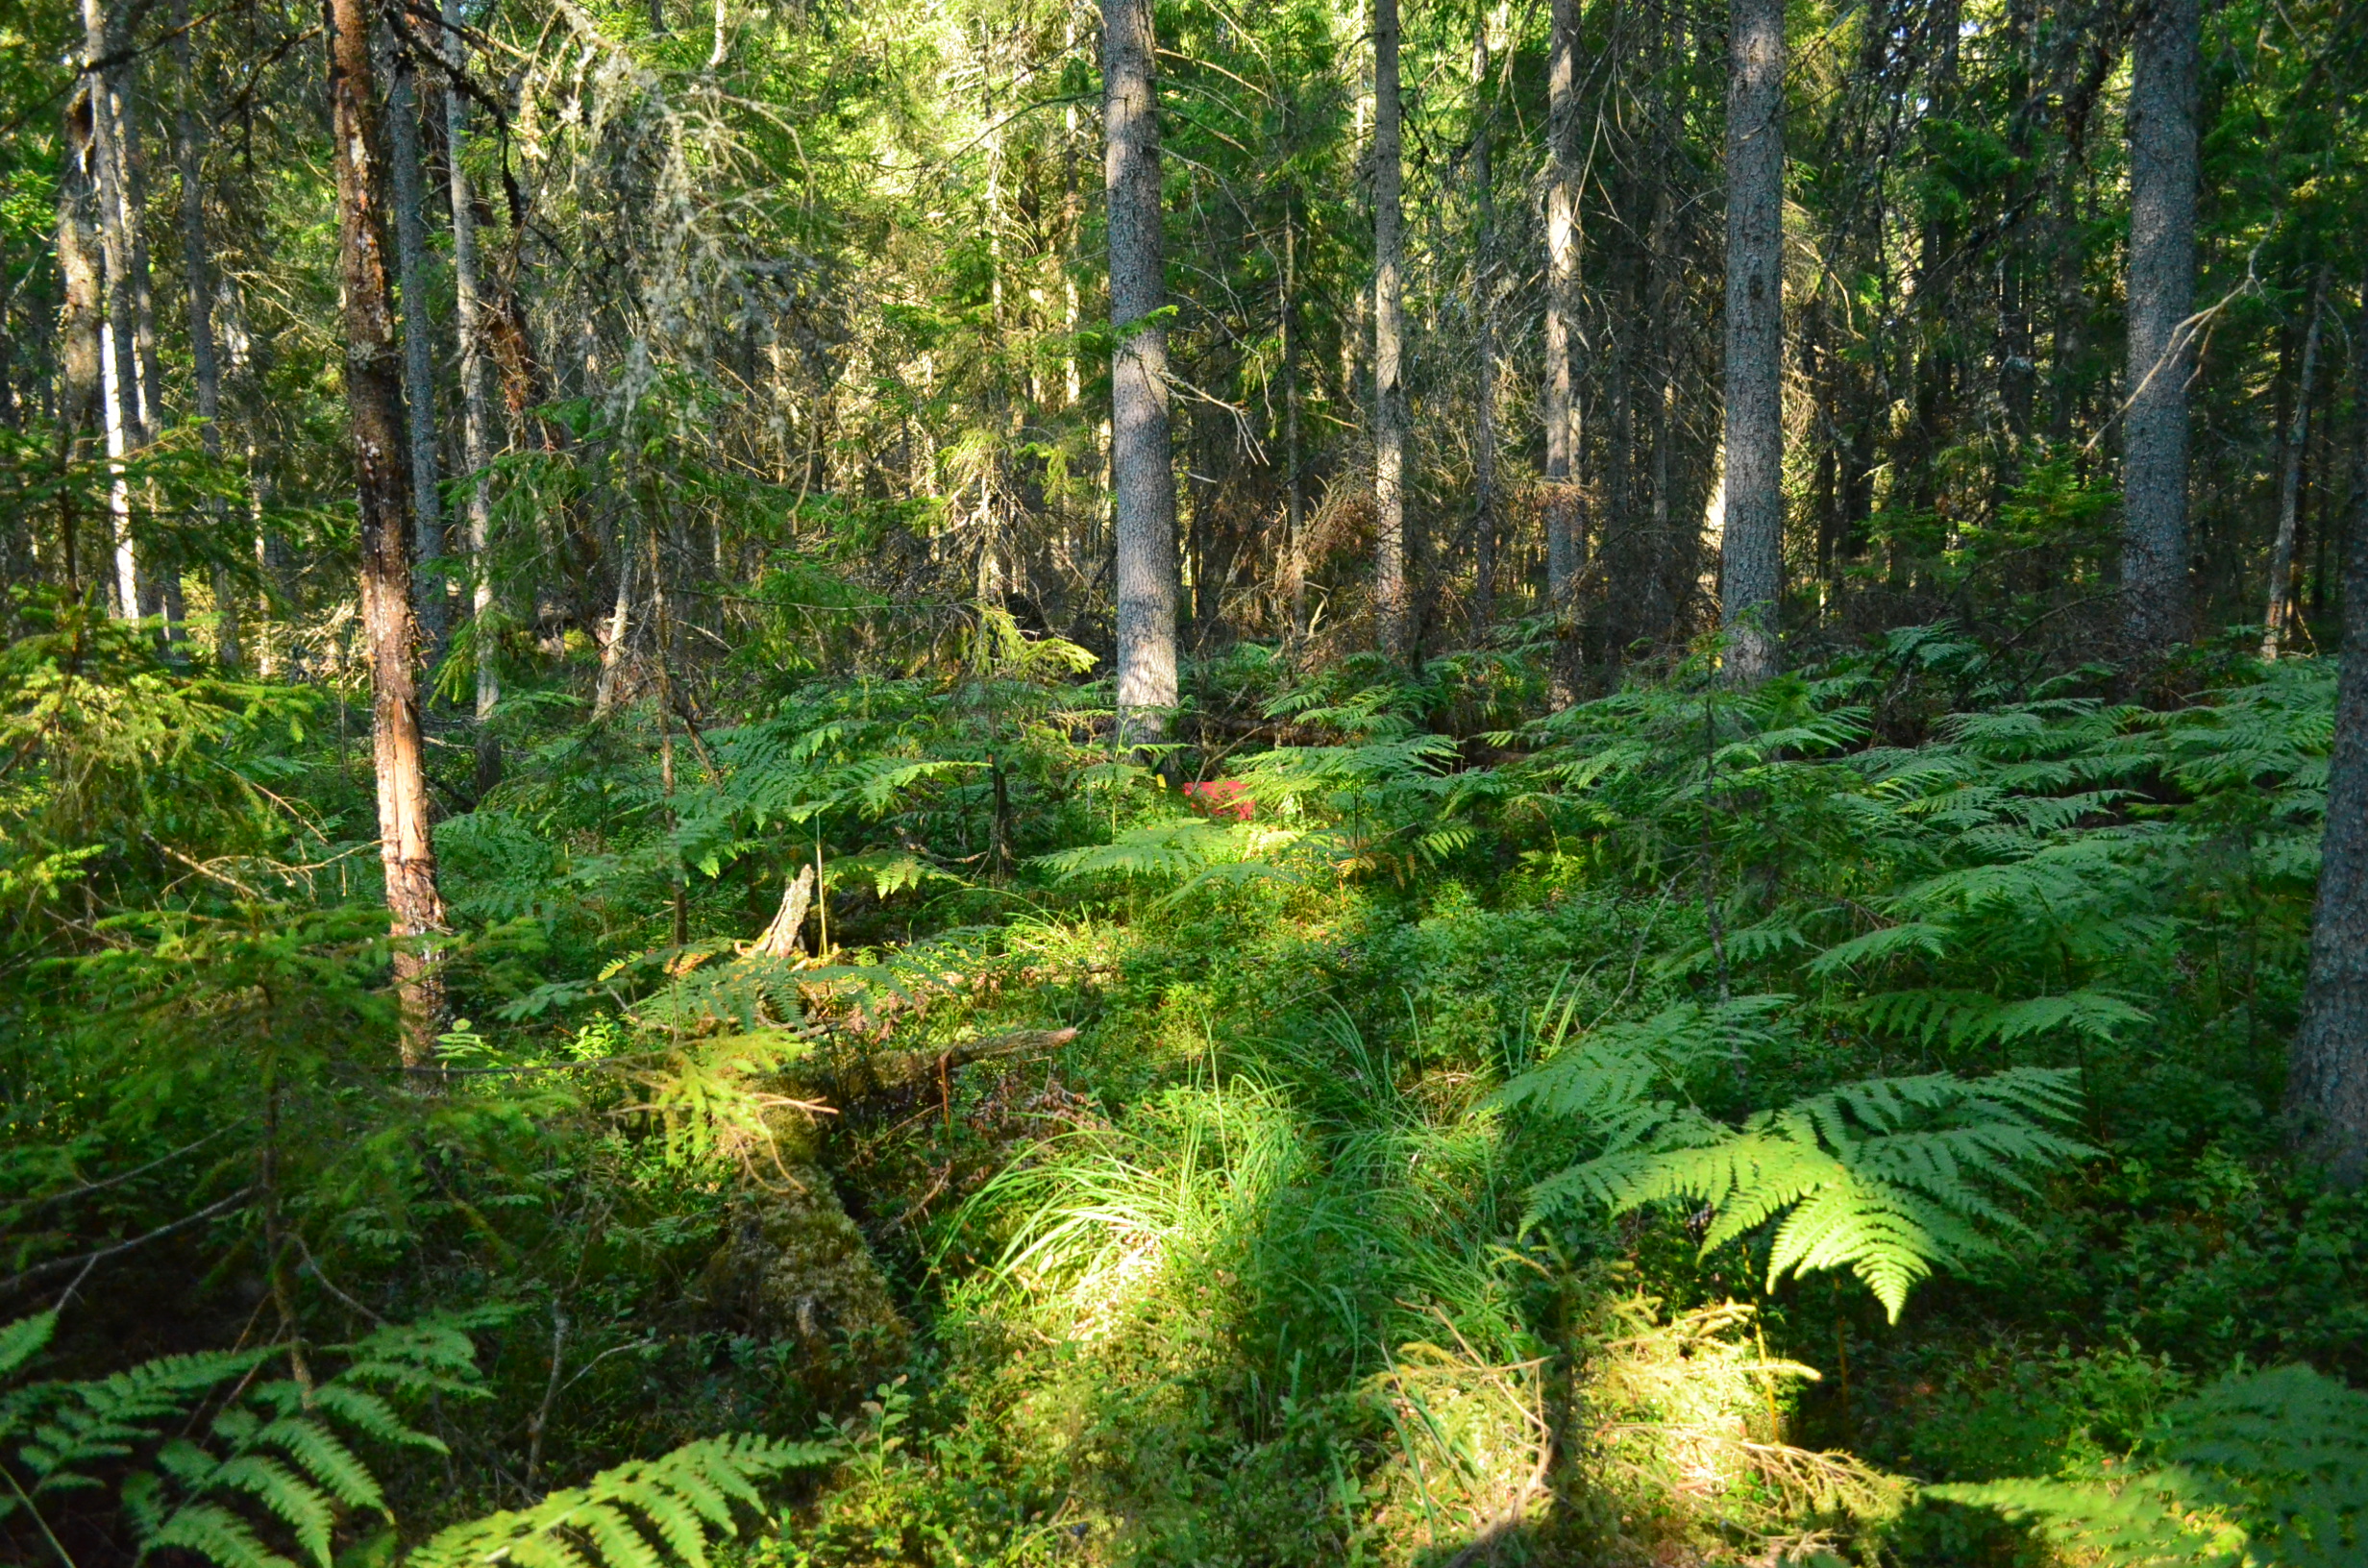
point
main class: Woodland
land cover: Spruce dominated coniferous woodland
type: hemiboreal forest and nemoral coniferous forest and mixed broadleaved-coniferous forest
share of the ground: 50 - 75 %
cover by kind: coniferous forest trees 60 %, shrubs 15 %, herbaceous plants 10 %, lichens and mosses 10 %, broadleaved forest trees 5 %
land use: Forestry
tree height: > 5 m
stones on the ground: < 10 %
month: August
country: LV
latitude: 57.6375
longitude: 22.2592
